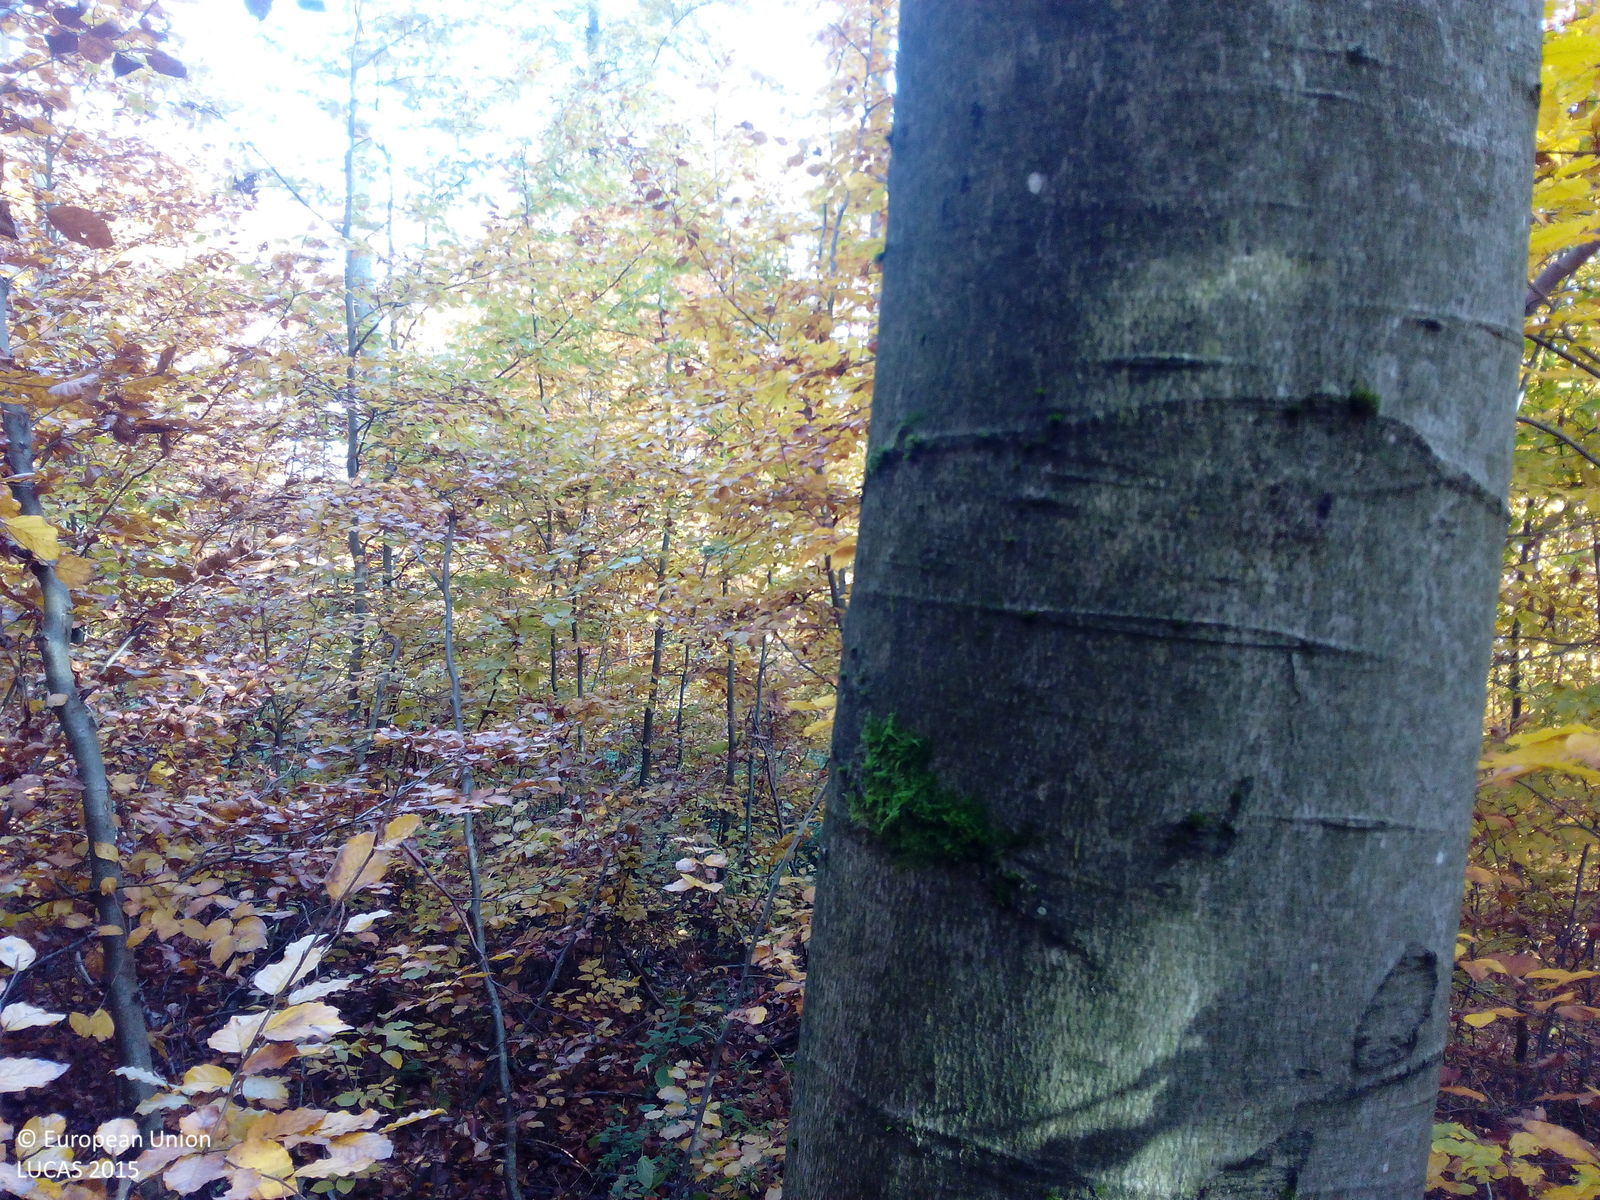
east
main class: Woodland
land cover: Broadleaved woodland
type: beech forest
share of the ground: > 75 %
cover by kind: broadleaved forest trees 85 %, unconsolidated bare surface 10 %, herbaceous plants 5 %
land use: Forestry
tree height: > 5 m
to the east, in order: Broadleaved woodland; Tracks; Broadleaved woodland; Tracks; Broadleaved woodland; Ditches and canals; Tracks; Broadleaved woodland
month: October
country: DE
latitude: 50.3281
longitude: 9.9579
